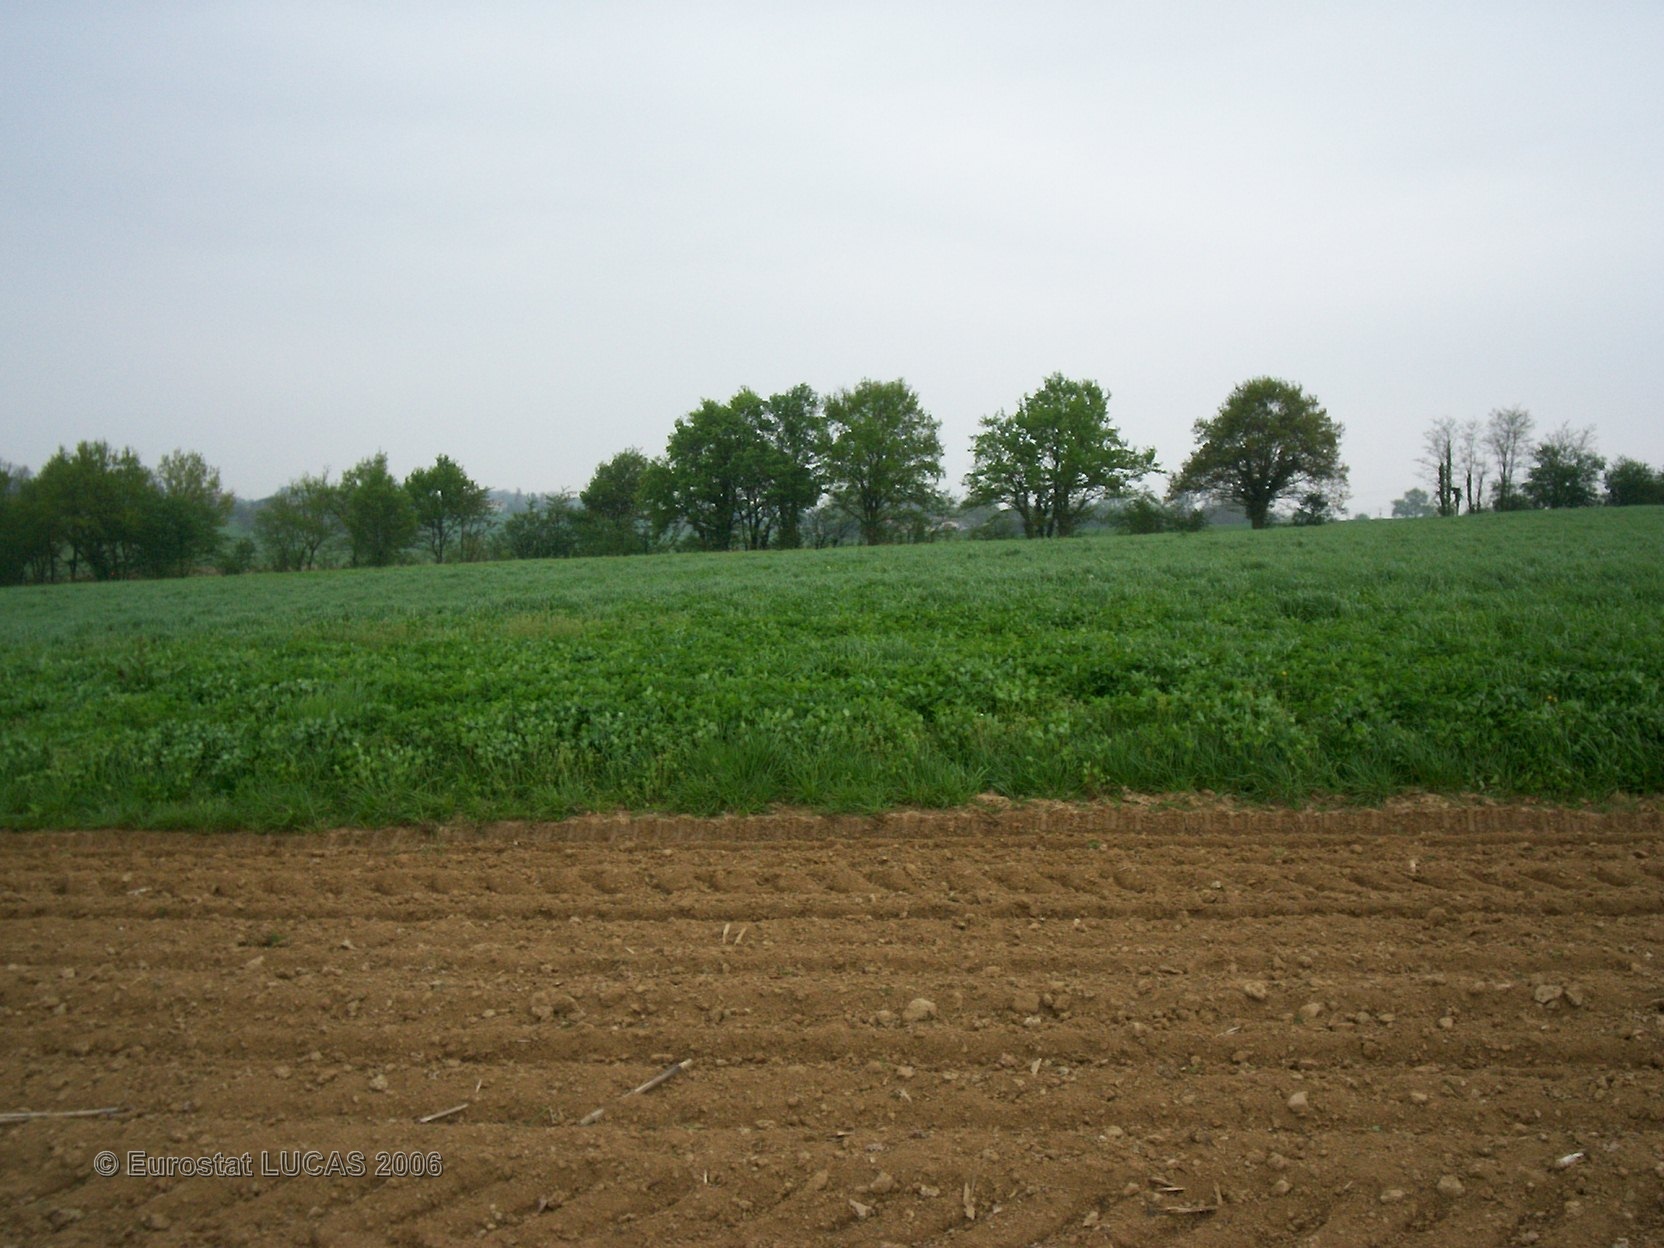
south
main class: Cropland
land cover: Maize
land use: Agriculture (excluding fallow land and kitchen gardens)
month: April
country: FR
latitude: 46.1196
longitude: 4.8654
